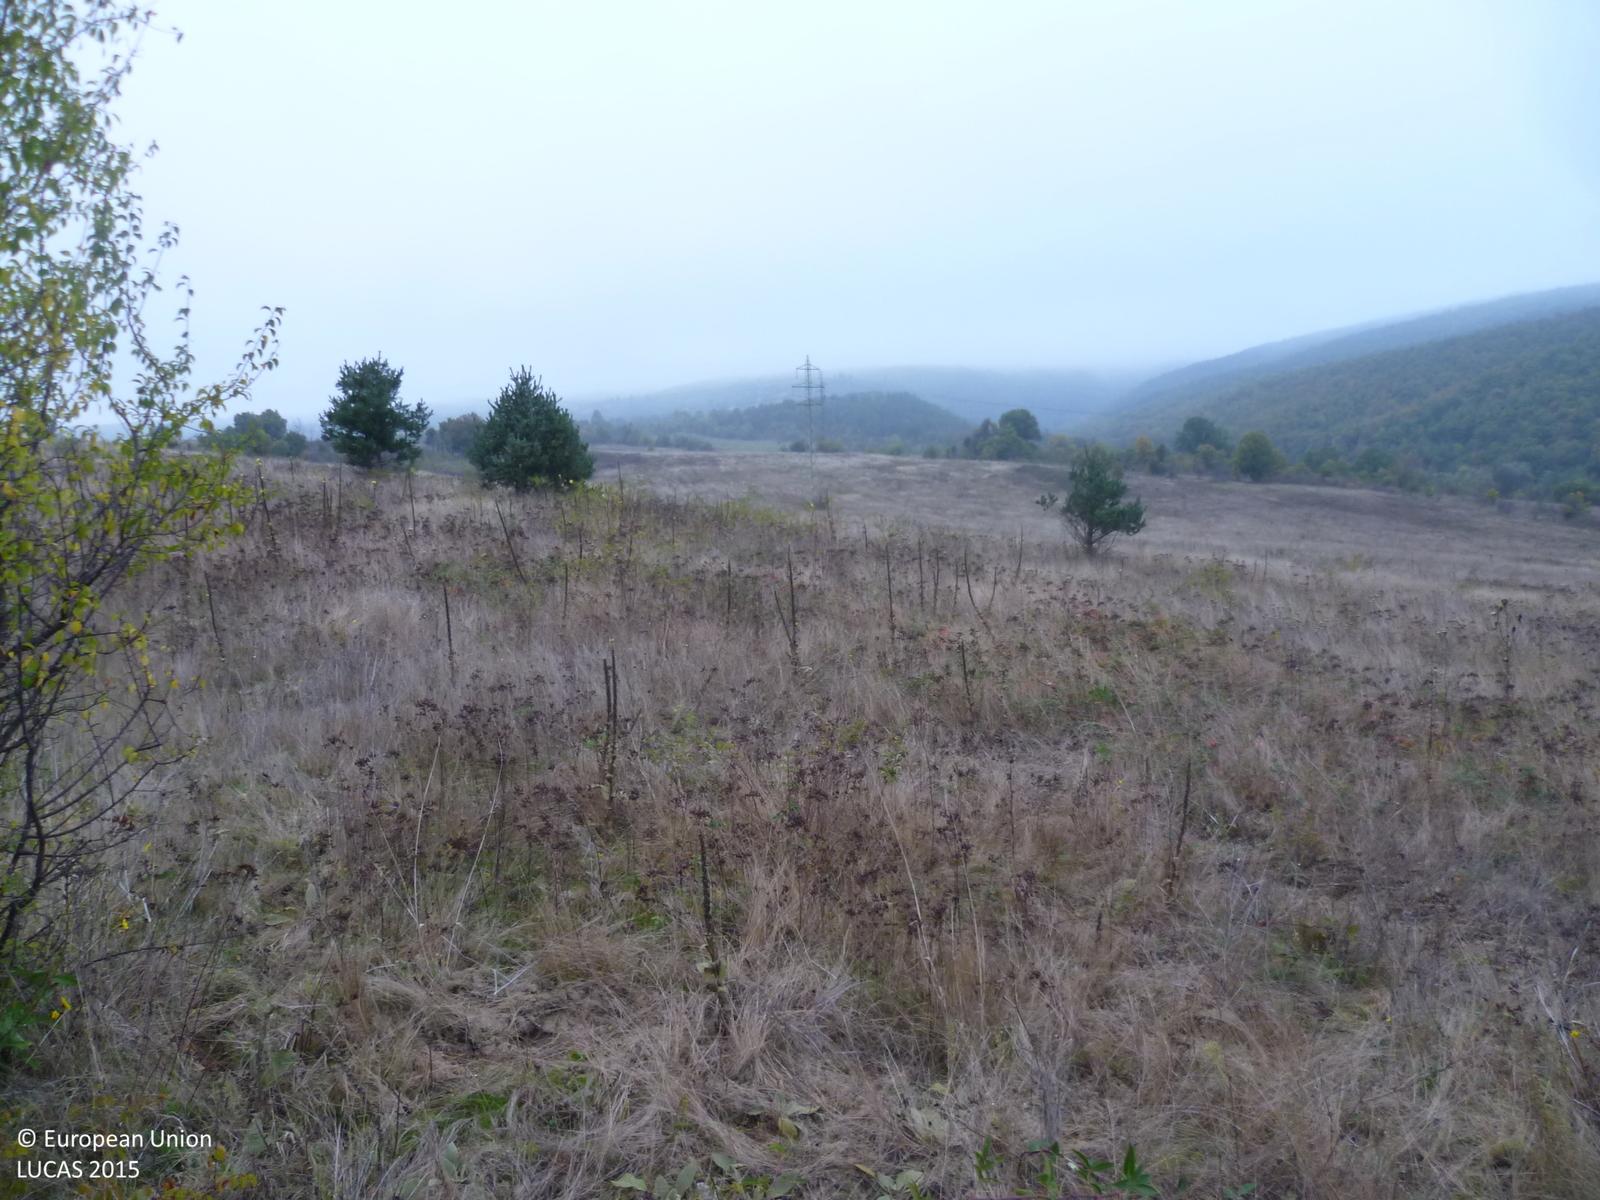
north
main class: Grassland
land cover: Grassland with sparse tree/shrub cover
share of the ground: > 75 %
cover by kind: herbaceous plants 90 %, broadleaved forest trees 5 %, shrubs 5 %
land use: Agriculture (excluding fallow land and kitchen gardens)
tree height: < 5 m
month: October
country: BG
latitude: 42.5152
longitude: 23.7562
